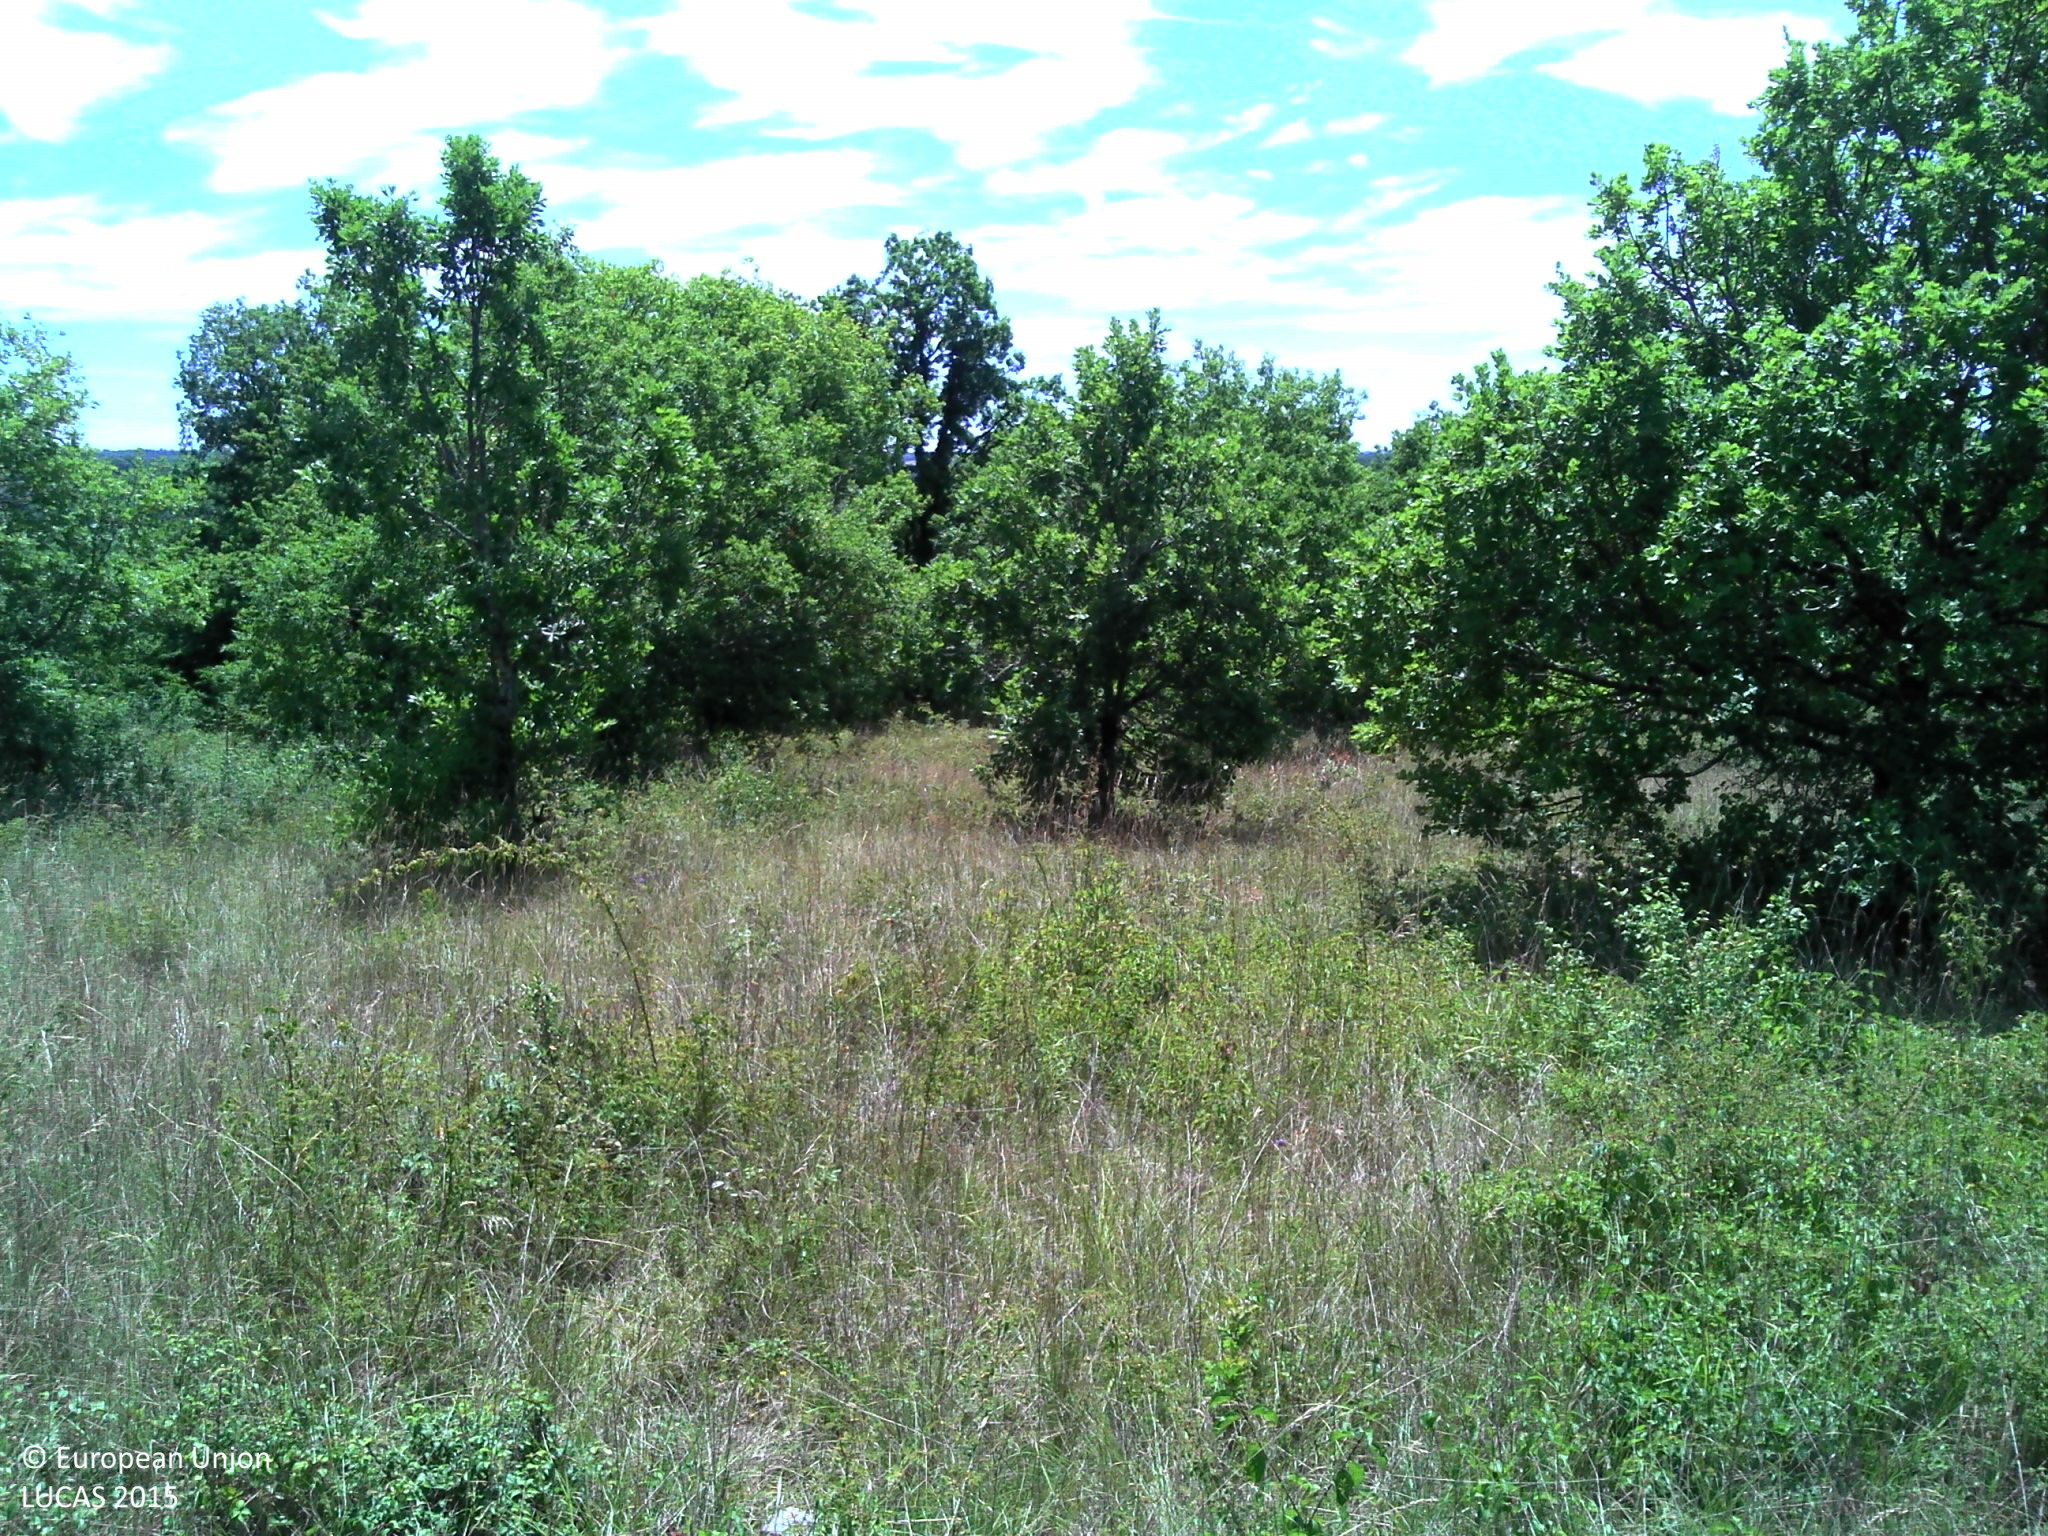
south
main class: Grassland
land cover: Grassland with sparse tree/shrub cover
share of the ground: > 75 %
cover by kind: herbaceous plants 95 %, broadleaved forest trees 5 %
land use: Agriculture (excluding fallow land and kitchen gardens)
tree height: < 5 m
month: June
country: FR
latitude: 44.7365
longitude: 1.6253
